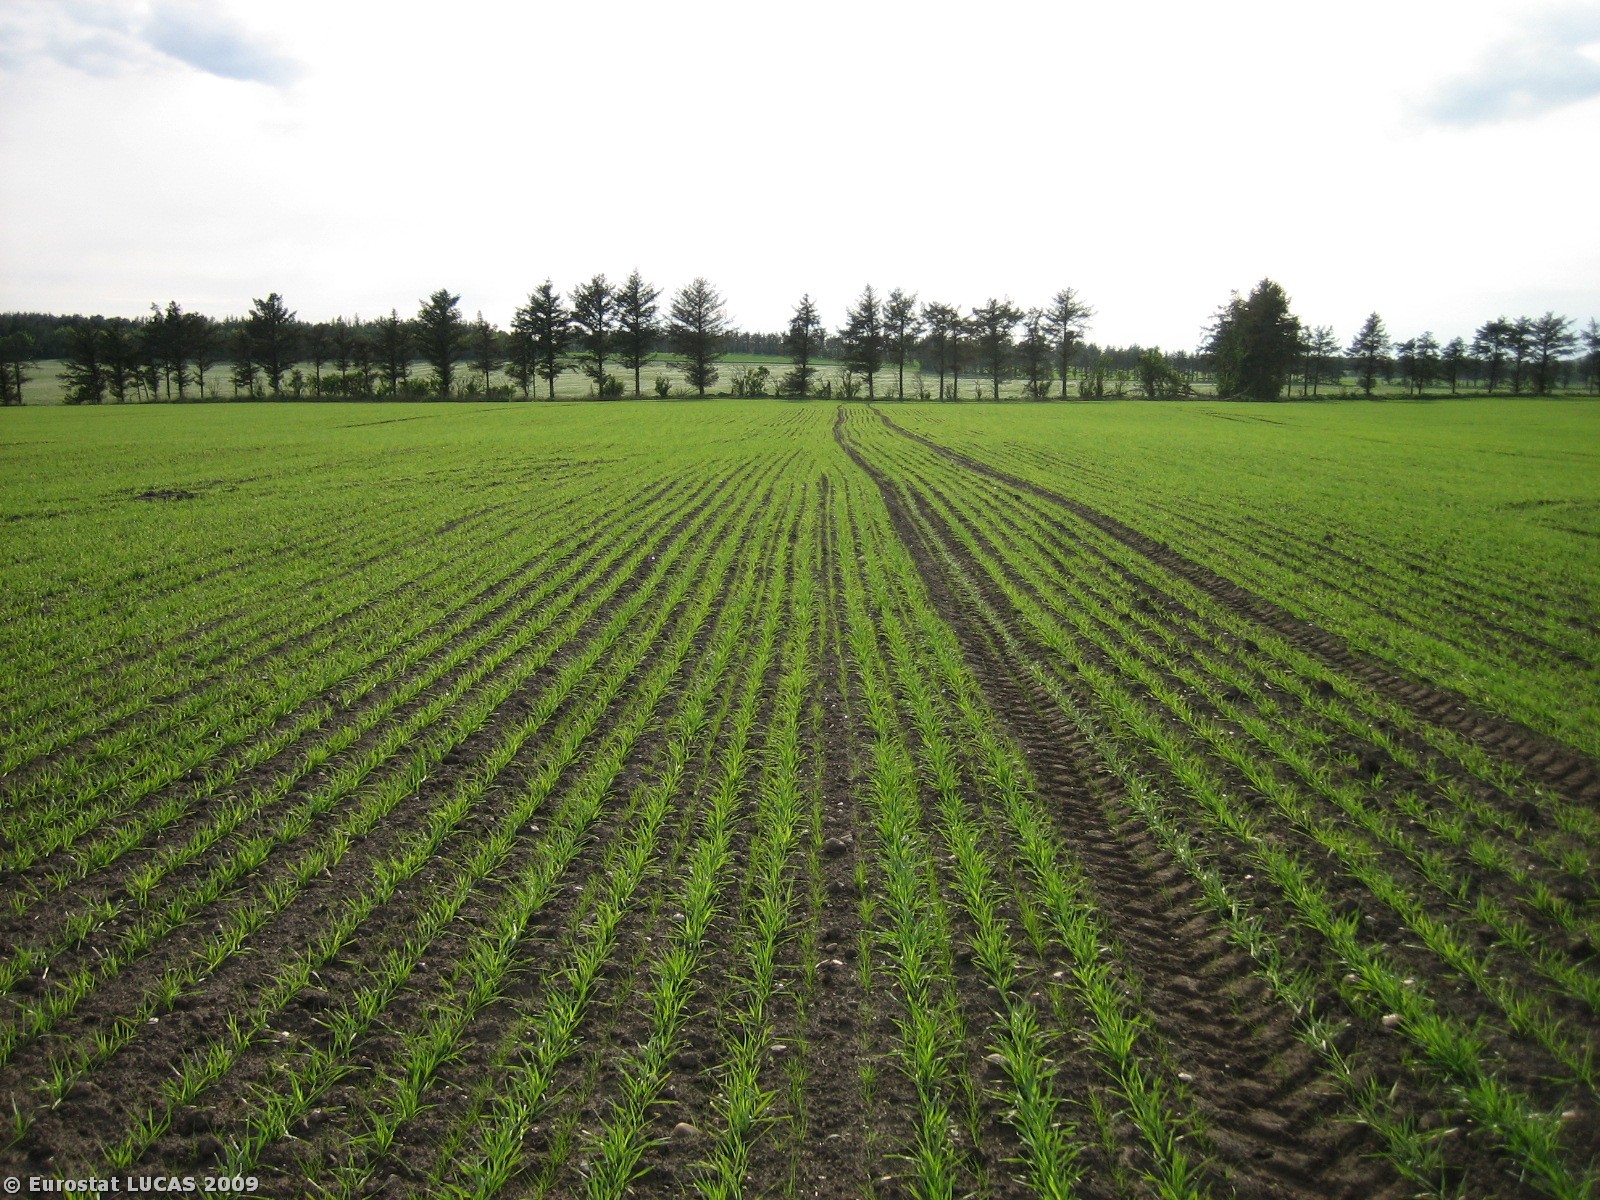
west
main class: Cropland
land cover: Barley
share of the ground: 25 - 50 %
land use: Agriculture (excluding fallow land and kitchen gardens)
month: May
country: DK
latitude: 56.1060
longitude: 8.4099
